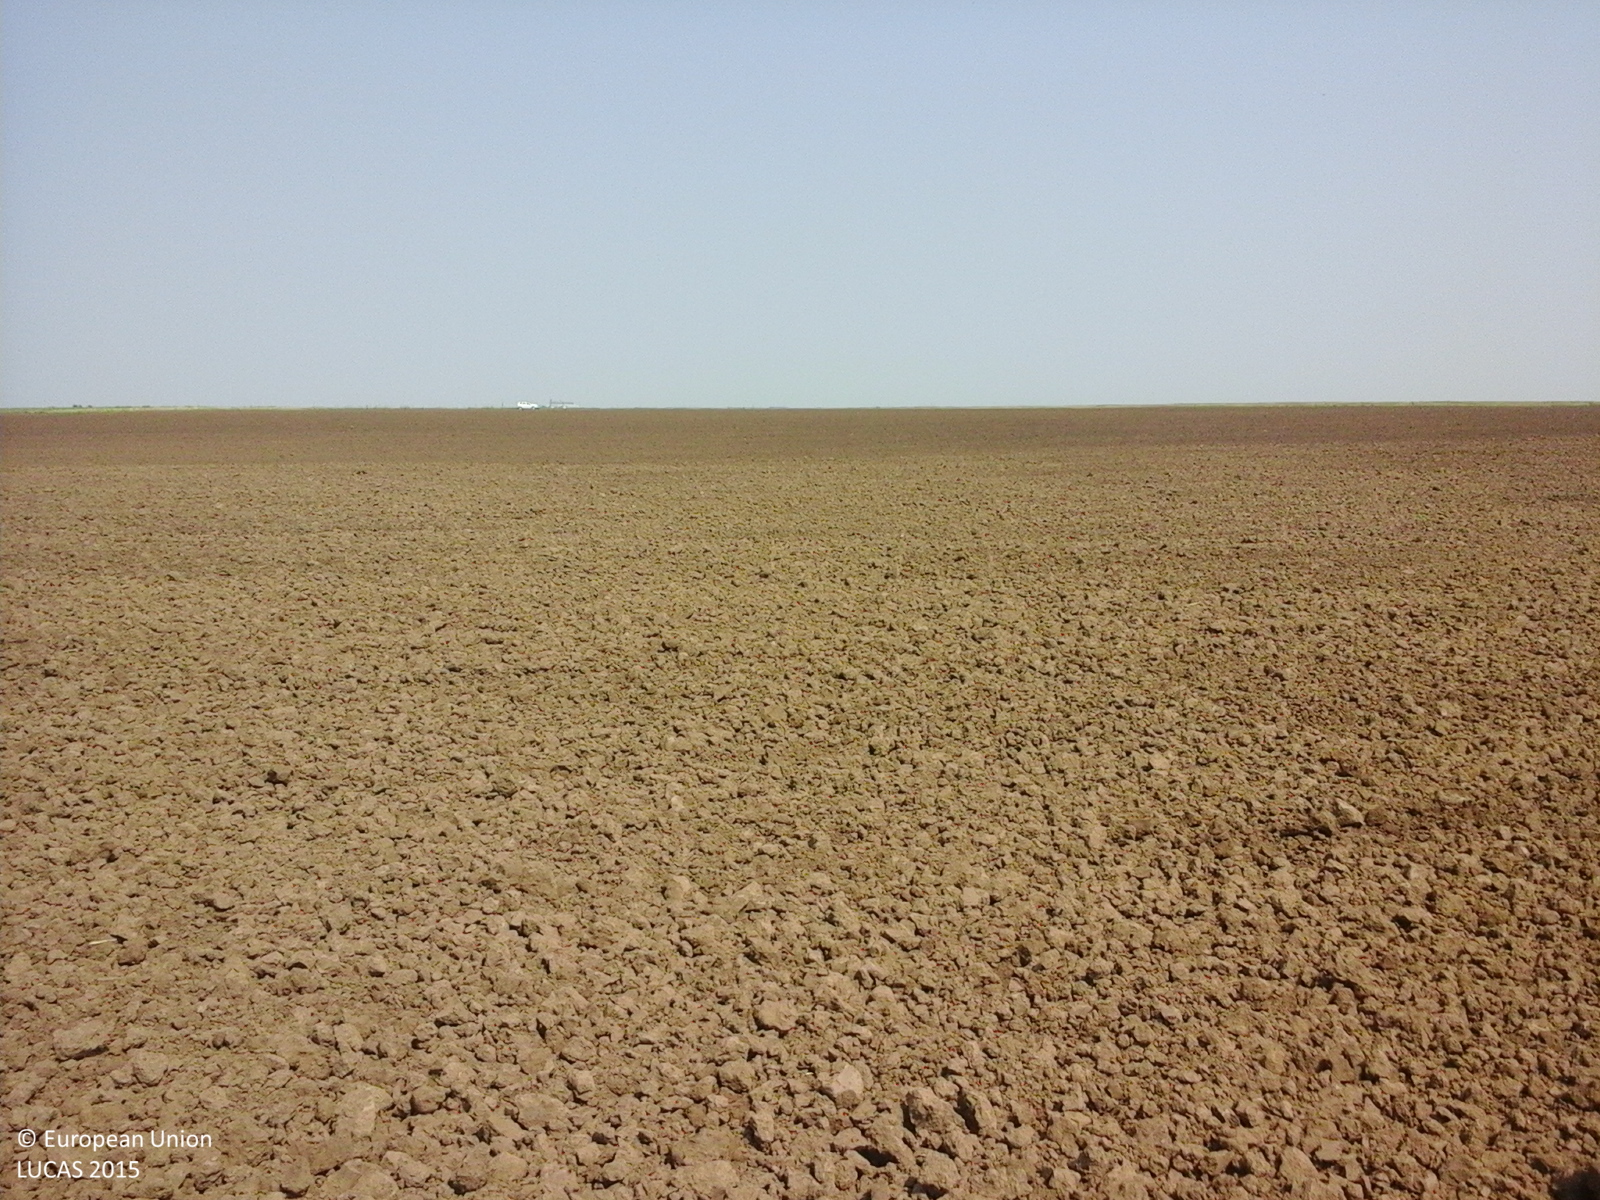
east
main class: Cropland
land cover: Rape and turnip rape
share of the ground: < 10 %
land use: Agriculture (excluding fallow land and kitchen gardens)
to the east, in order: Rape and turnip rape
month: July
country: RO
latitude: 44.5972
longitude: 26.7396
